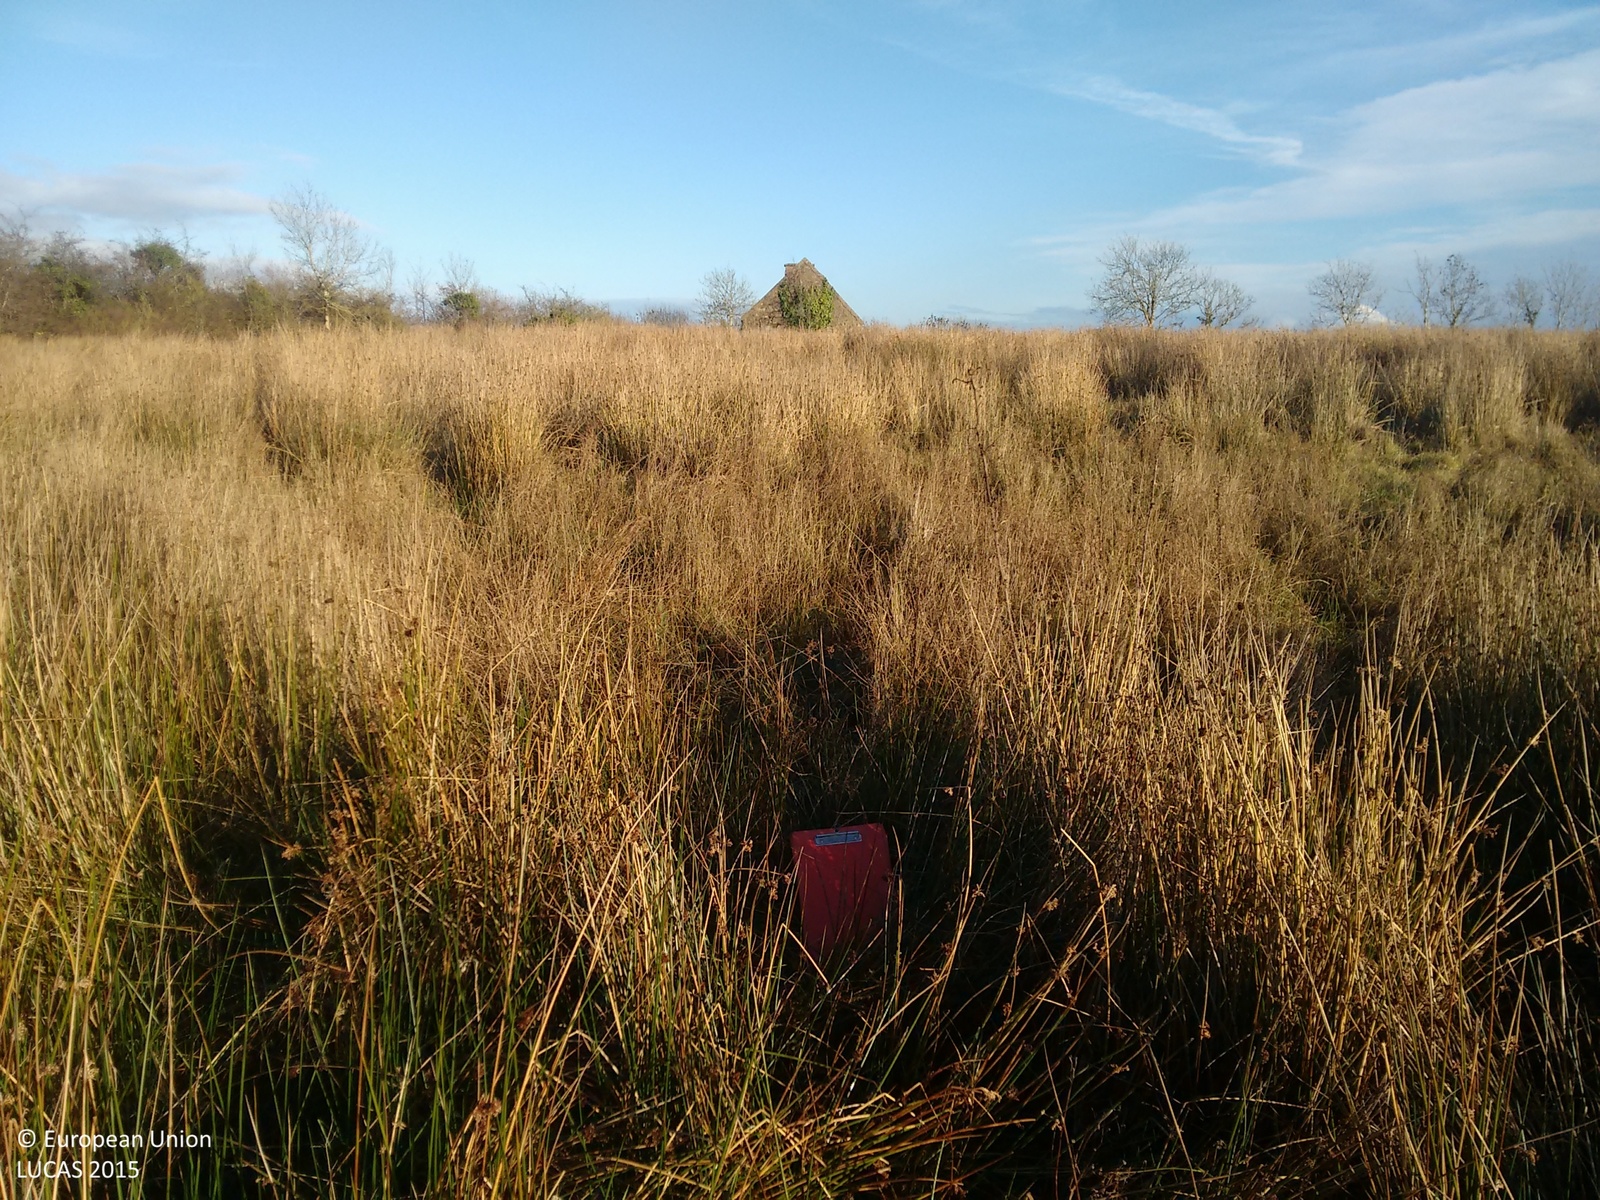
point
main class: Grassland
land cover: Grassland without tree/shrub cover
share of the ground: > 75 %
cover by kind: herbaceous plants 100 %
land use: Agriculture (excluding fallow land and kitchen gardens)
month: November
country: IE
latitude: 53.9752
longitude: -7.8710
